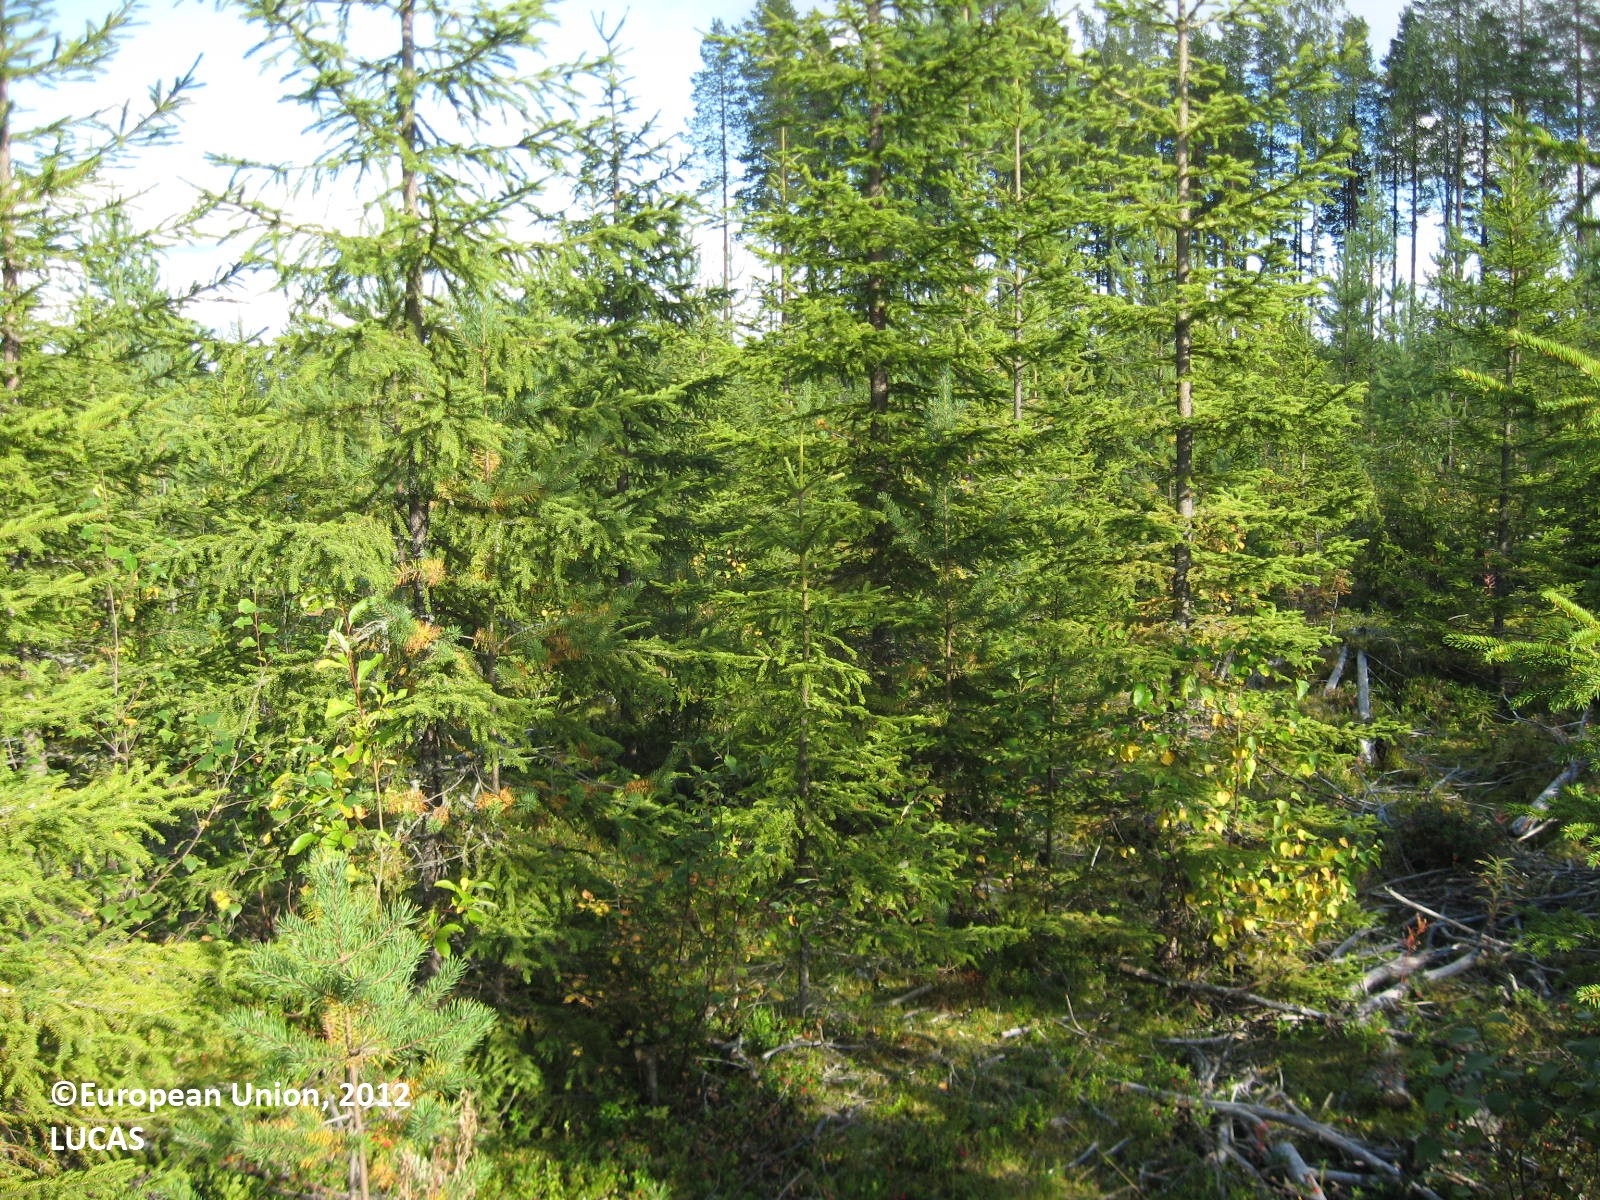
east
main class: Woodland
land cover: Spruce dominated coniferous woodland
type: boreal forest
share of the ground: > 75 %
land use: Forestry
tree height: < 5 m
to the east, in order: Spruce dominated coniferous woodland; Spruce dominated mixed woodland; Pine dominated mixed woodland
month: August
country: FI
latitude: 63.9547
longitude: 29.9374
